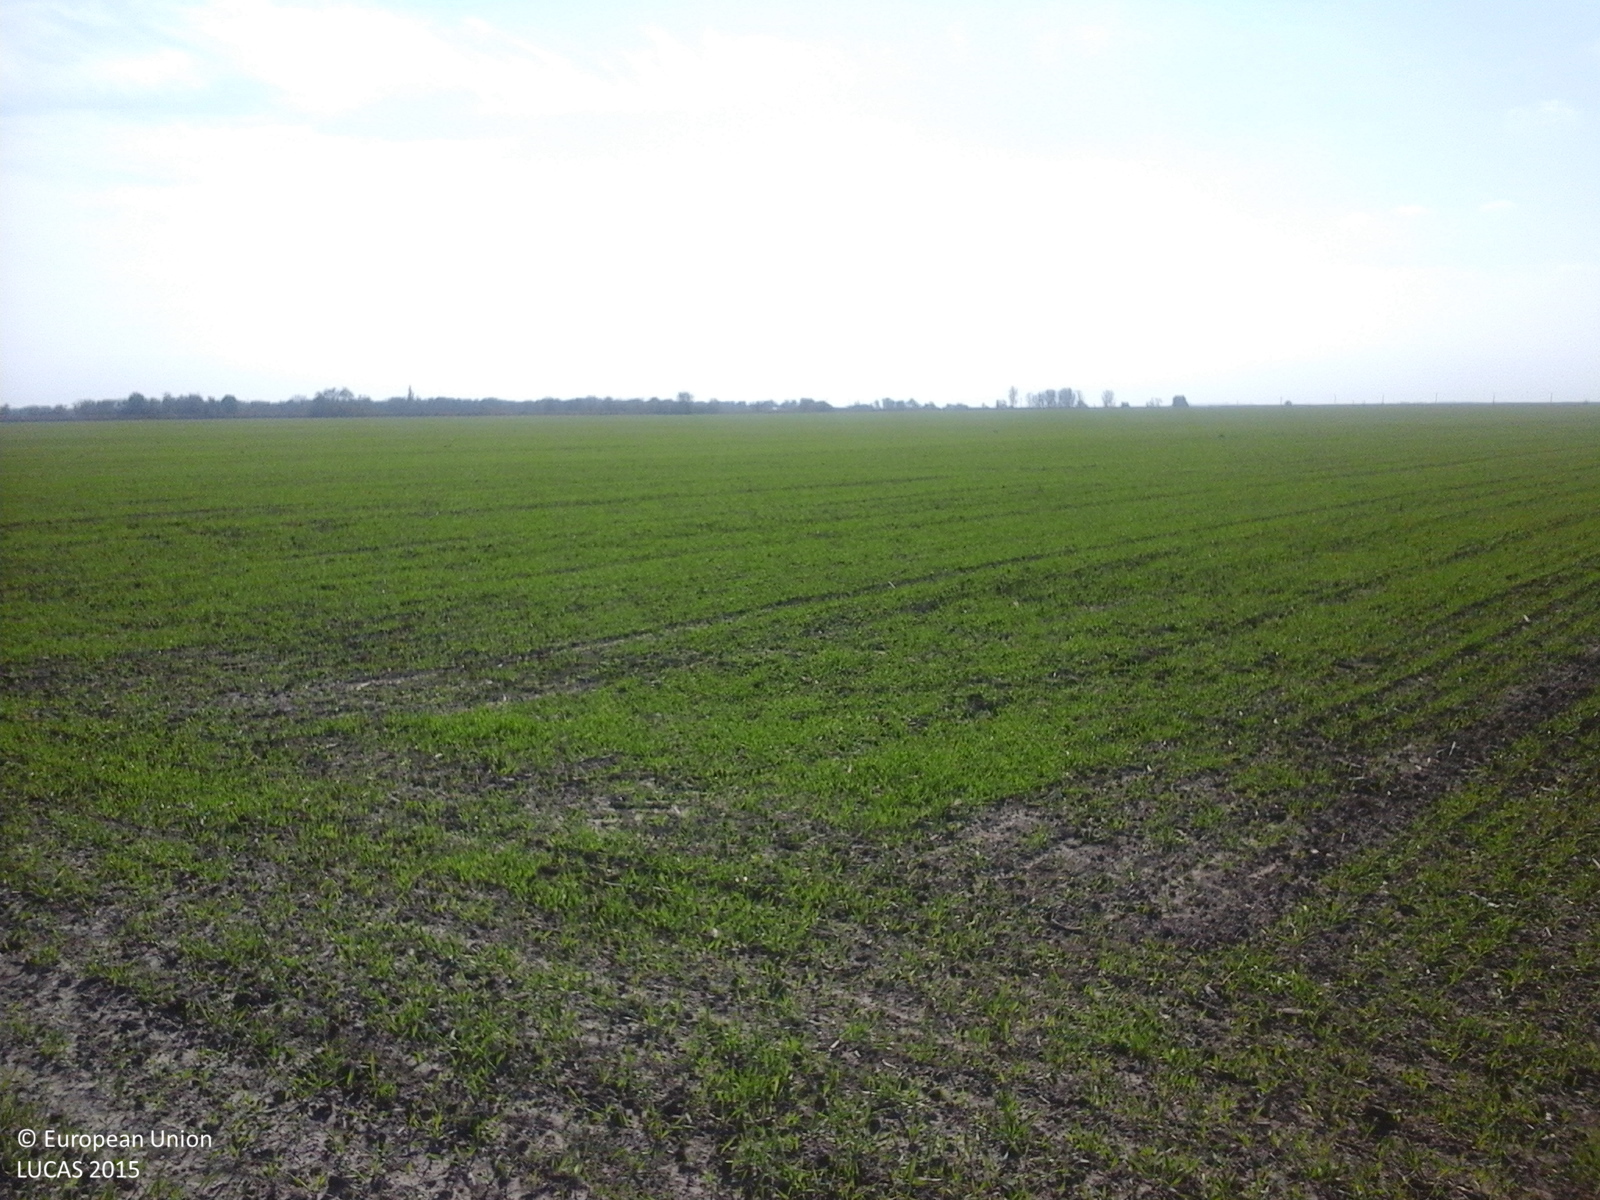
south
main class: Cropland
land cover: Common wheat
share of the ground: 25 - 50 %
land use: Agriculture (excluding fallow land and kitchen gardens)
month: October
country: RO
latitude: 45.3055
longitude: 27.3521
